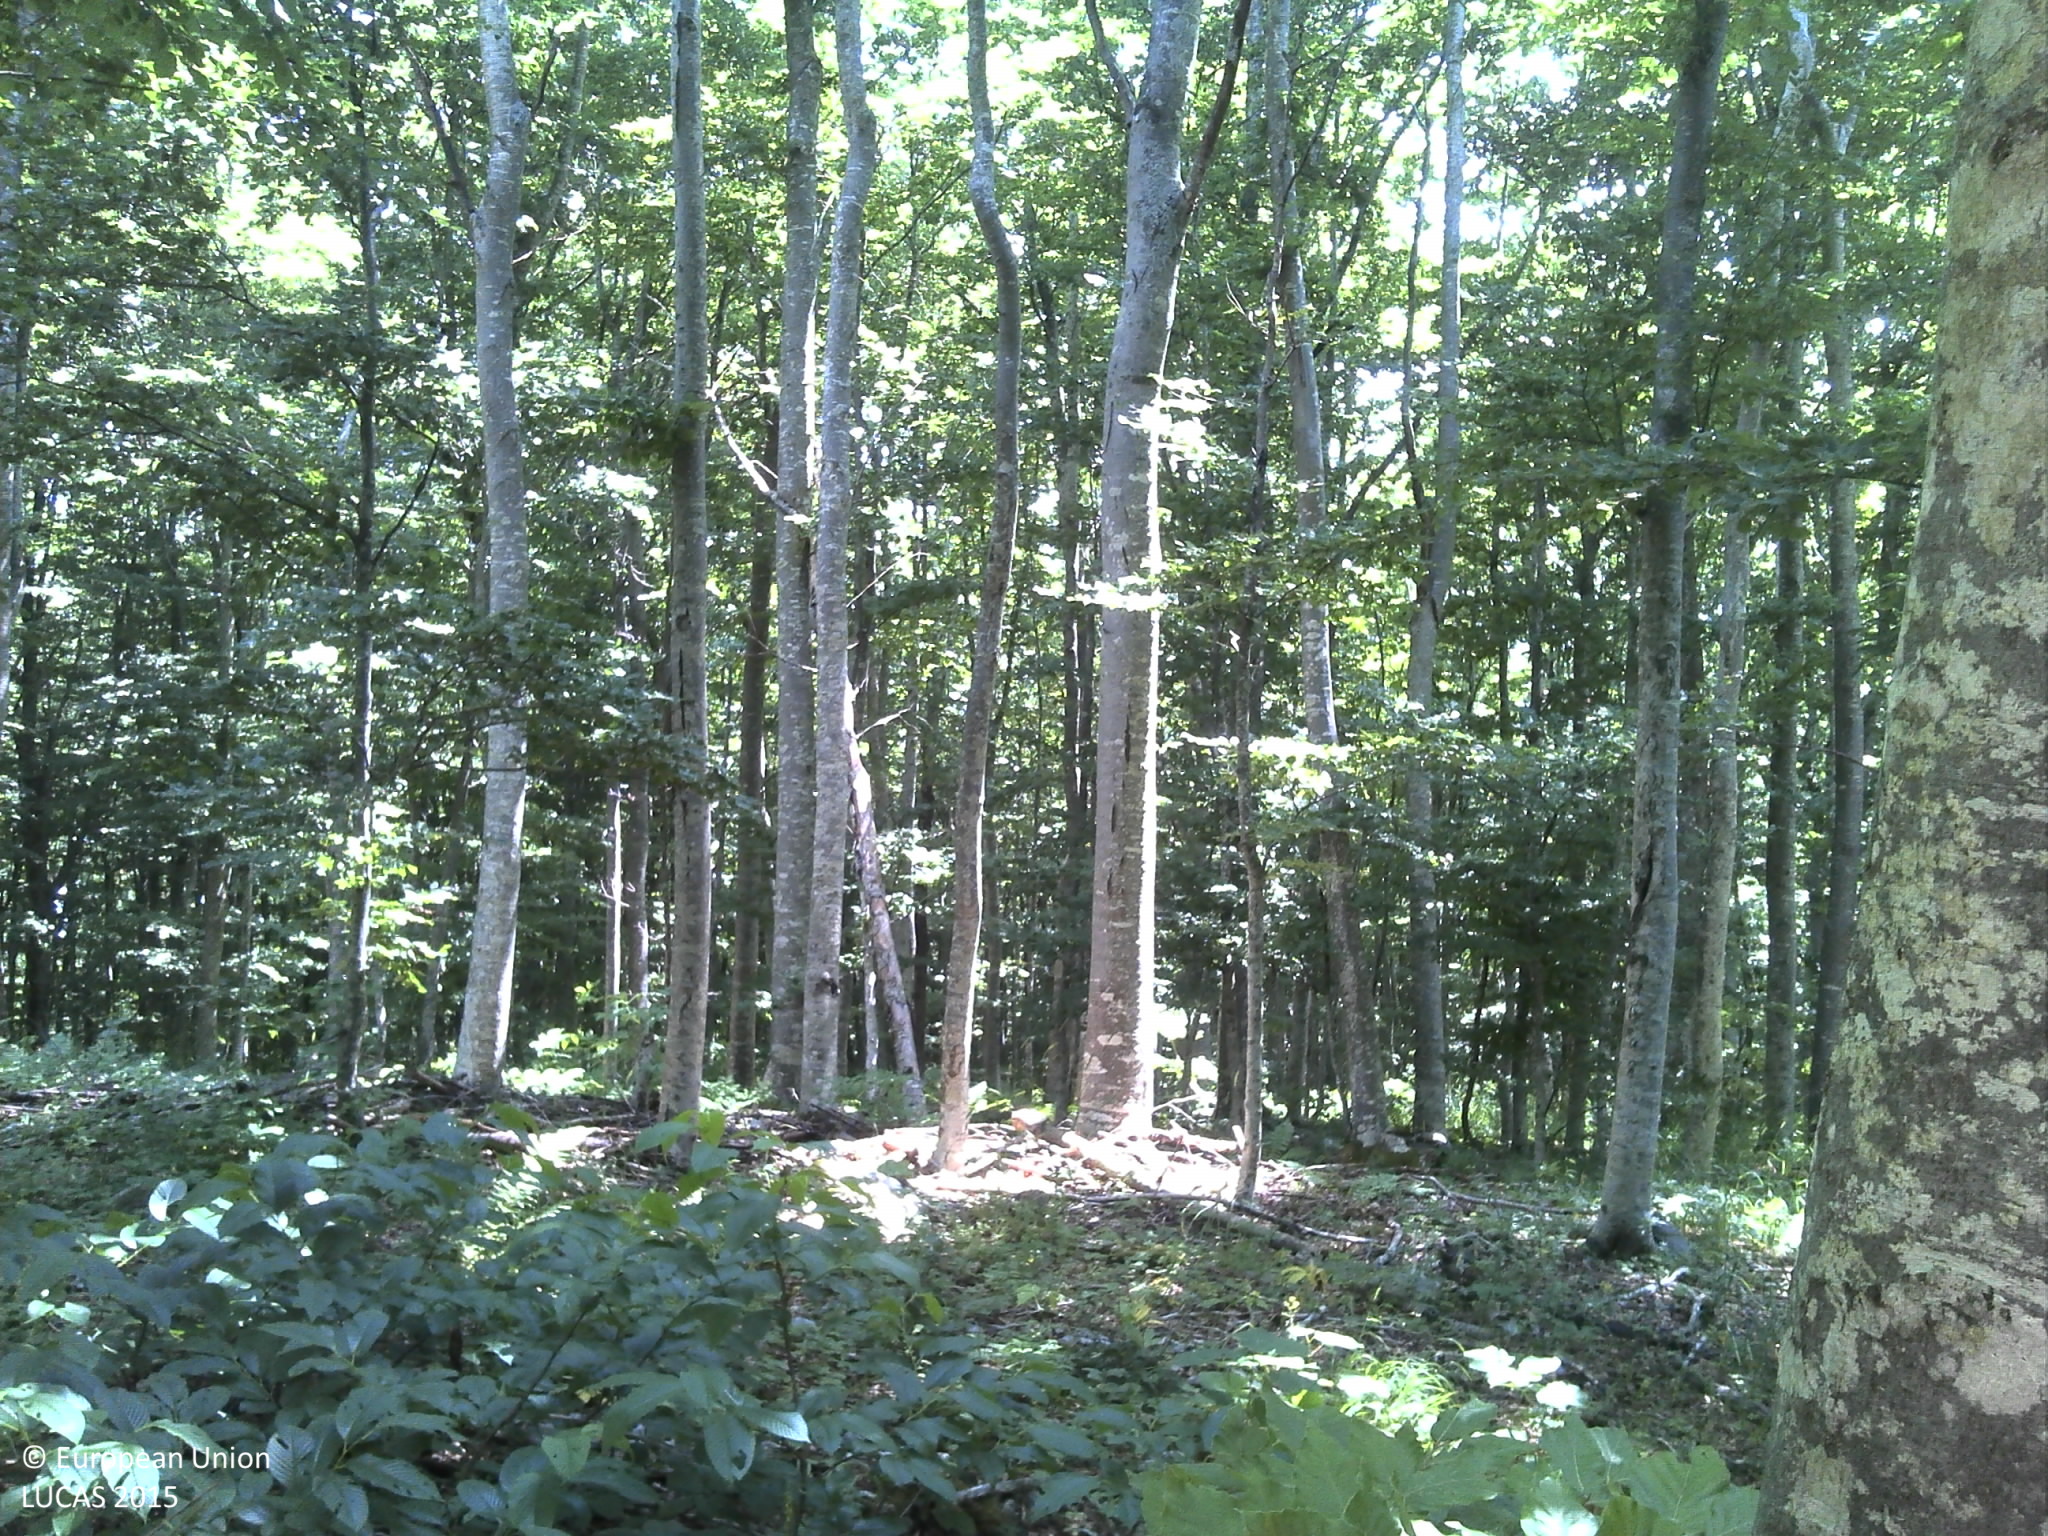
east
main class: Woodland
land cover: Broadleaved woodland
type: mountainous beech forest
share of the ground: > 75 %
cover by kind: broadleaved forest trees 95 %, consolidated bare surface 5 %
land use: Forestry
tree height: > 5 m
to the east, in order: Broadleaved woodland
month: June
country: HR
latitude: 44.5042
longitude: 15.9683
